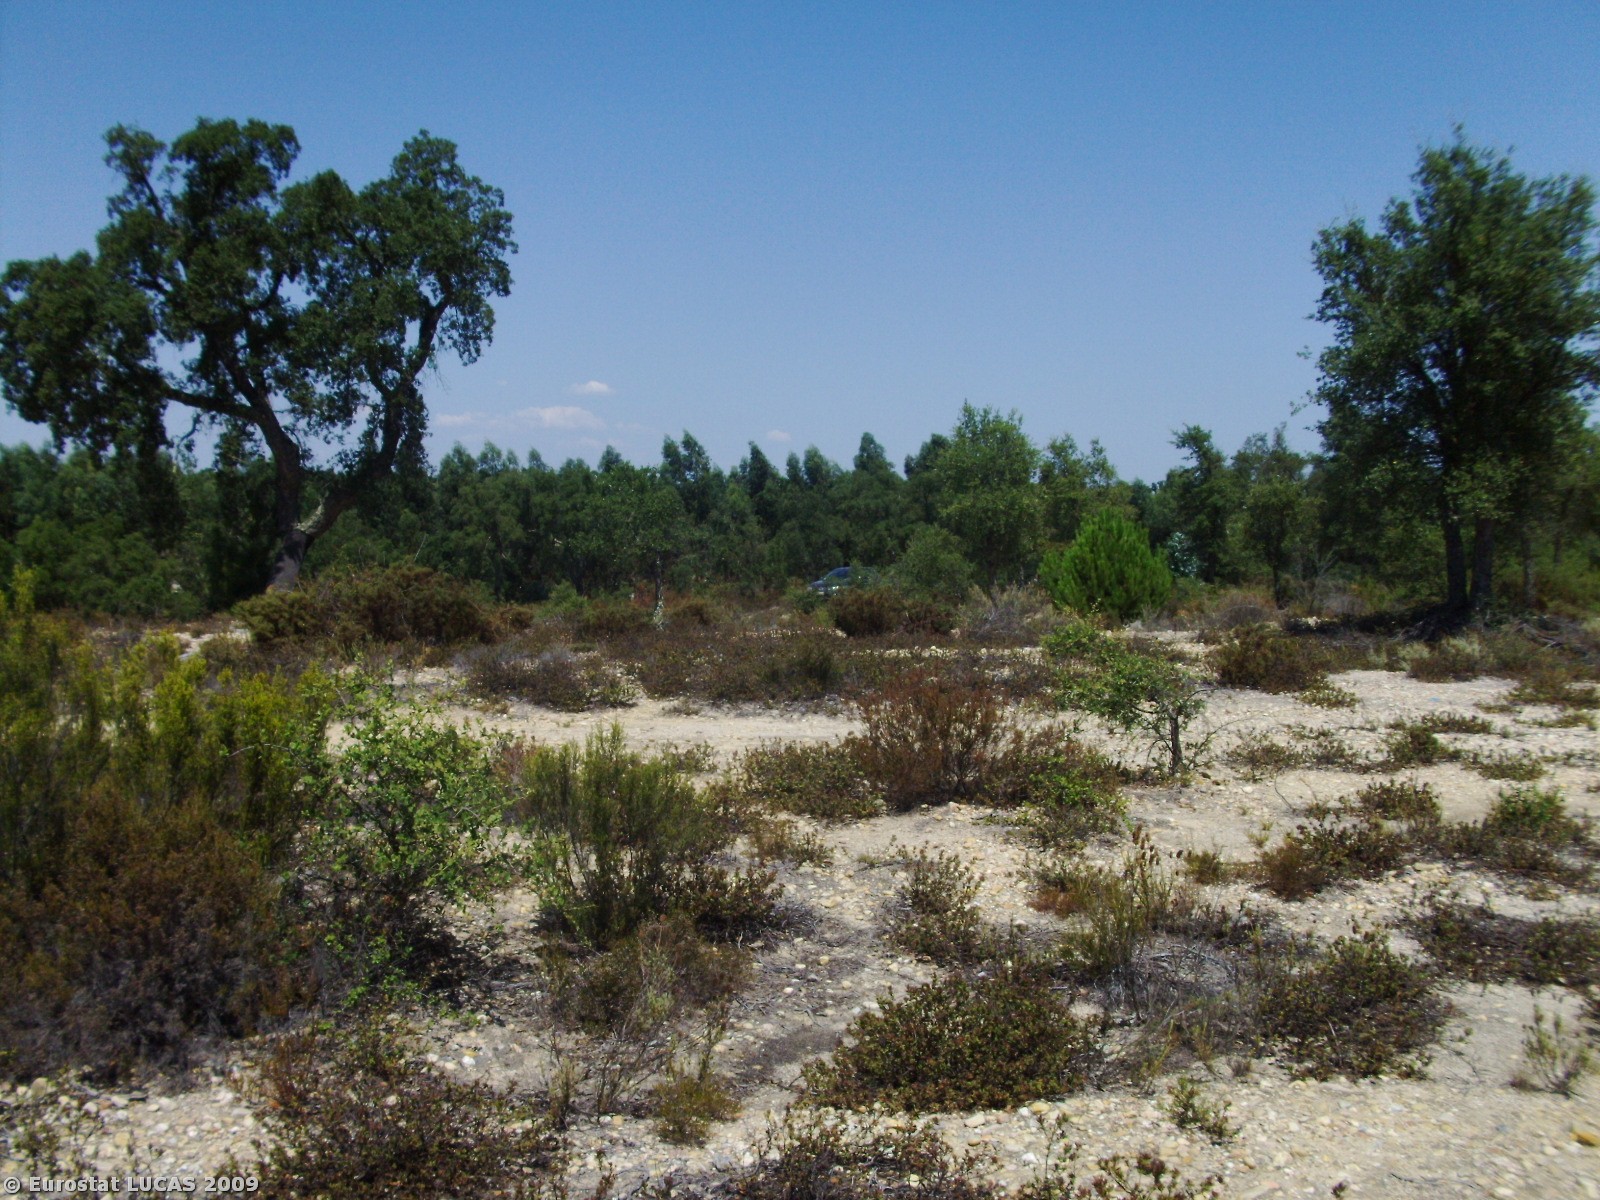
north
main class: Woodland
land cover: Mixed woodland
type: hemiboreal forest and nemoral coniferous forest and mixed broadleaved-coniferous forest
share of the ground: 10 - 25 %
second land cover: Spontaneously vegetated surfaces
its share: 50 - 75 %
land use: Forestry
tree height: > 5 m
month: August
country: PT
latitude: 39.2345
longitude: -8.0946
